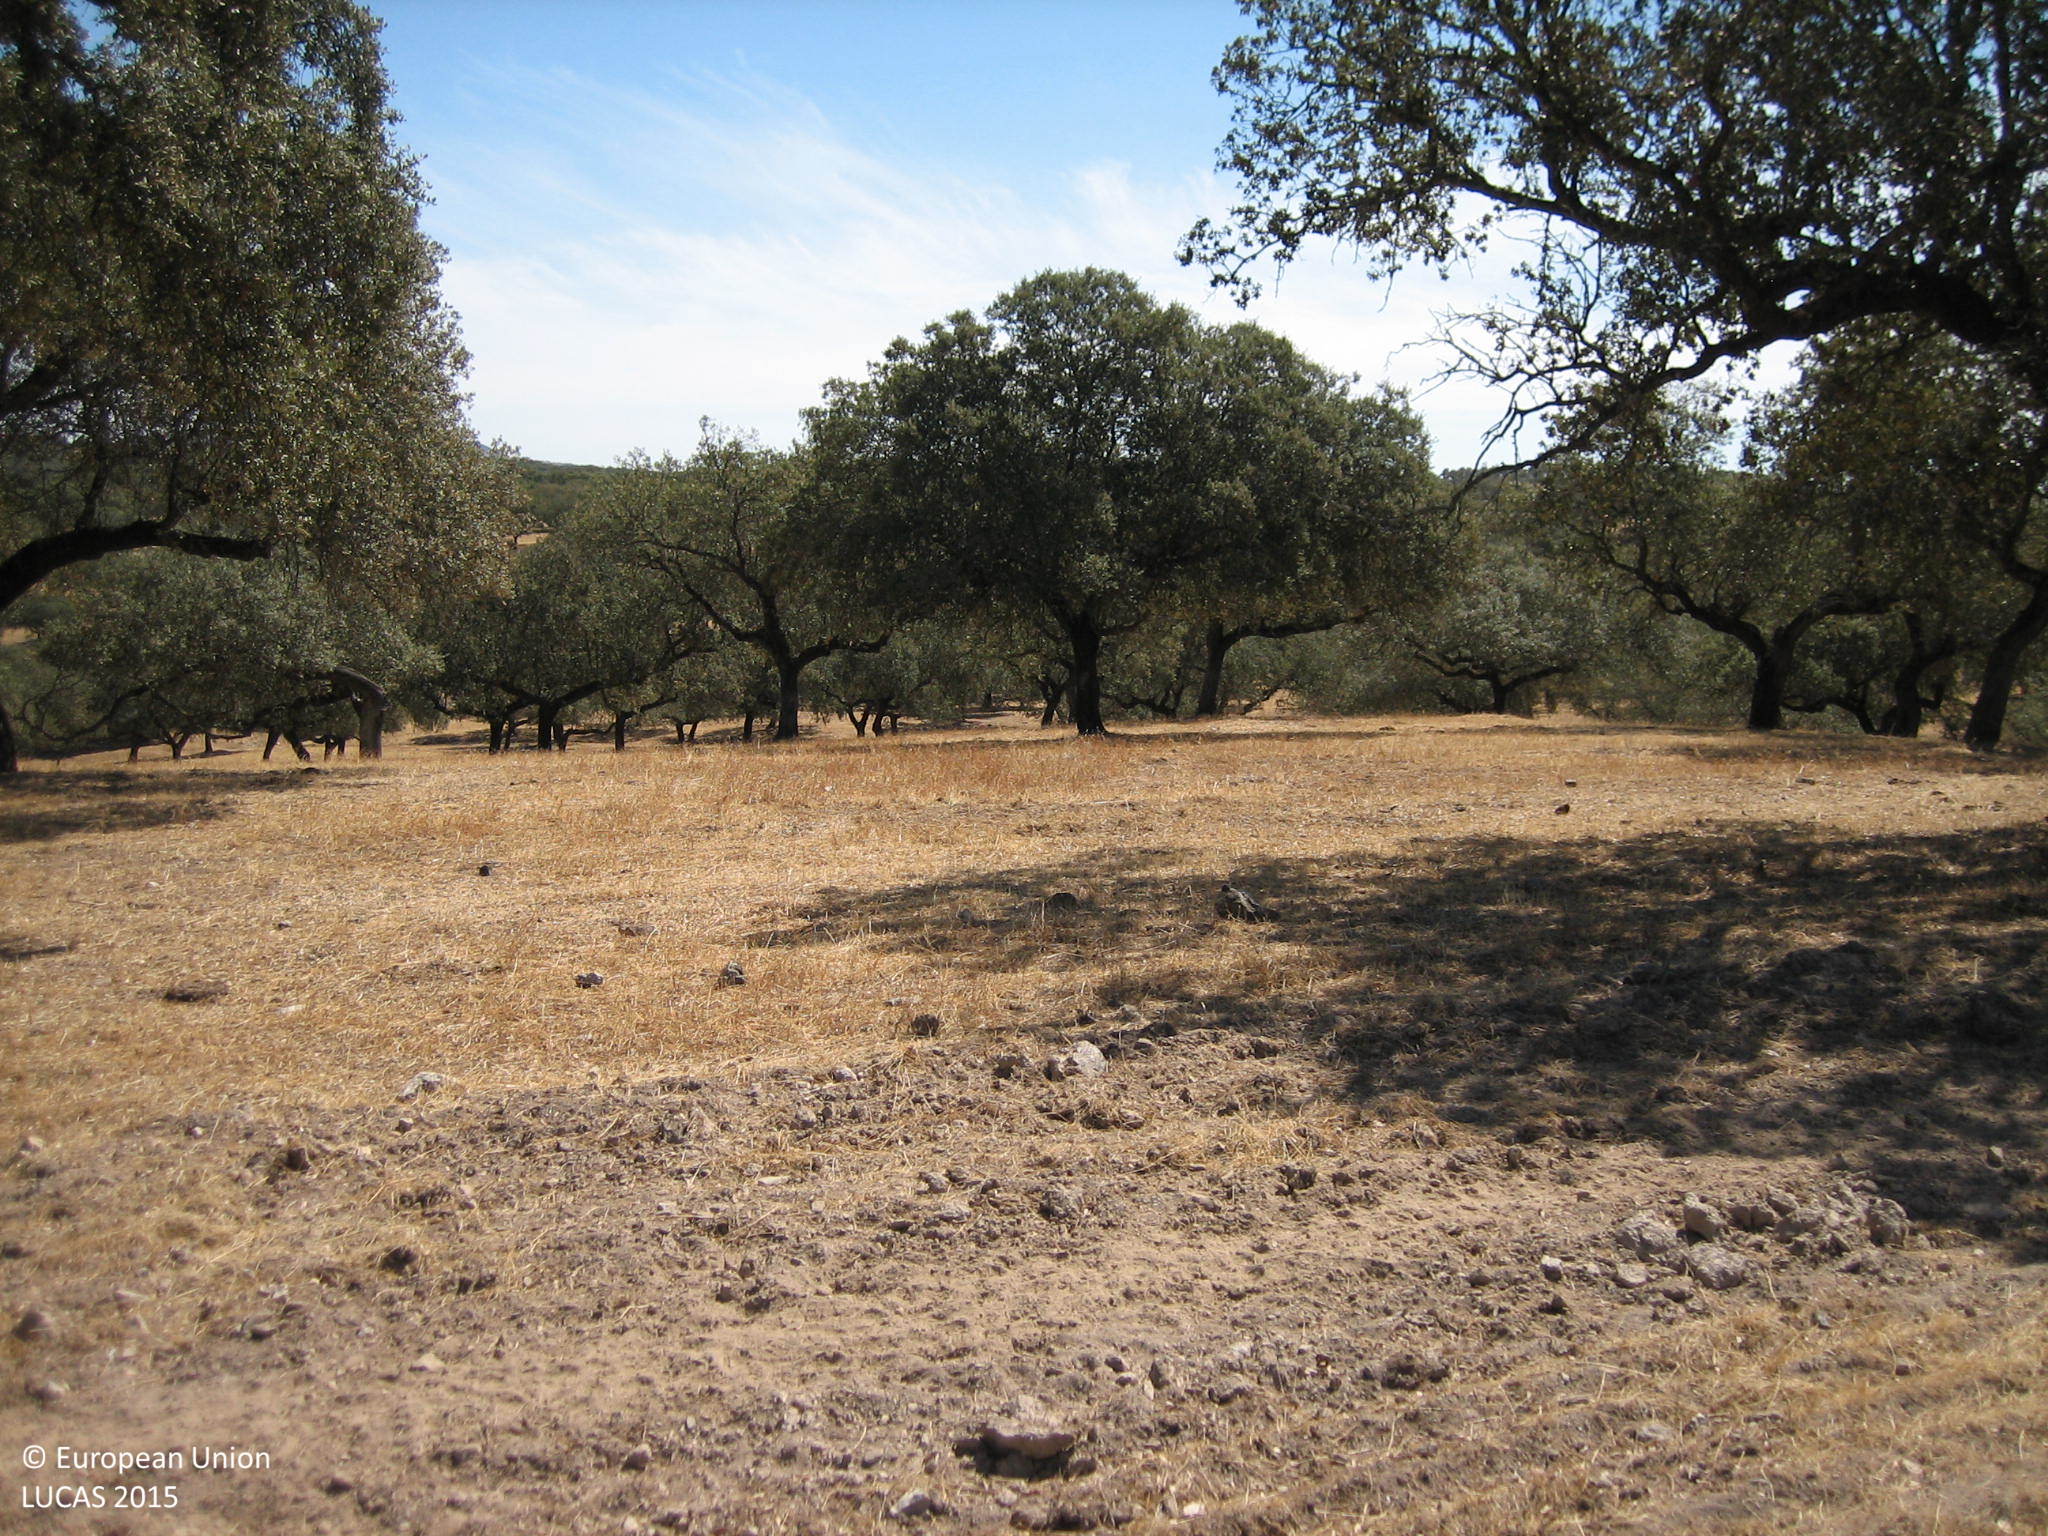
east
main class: Woodland
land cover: Broadleaved woodland
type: broadleaved evergreen forest
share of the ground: 10 - 25 %
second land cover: Grassland without tree/shrub cover
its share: 50 - 75 %
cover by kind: herbaceous plants 60 %, unconsolidated bare surface 30 %, broadleaved forest trees 10 %
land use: Forestry
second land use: Agriculture (excluding fallow land and kitchen gardens)
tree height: > 5 m
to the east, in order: Broadleaved woodland; Grassland without tree/shrub cover; Fences; Dry stone walls; Other structural elements; Broadleaved woodland
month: August
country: ES
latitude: 38.4980
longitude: -7.1862
